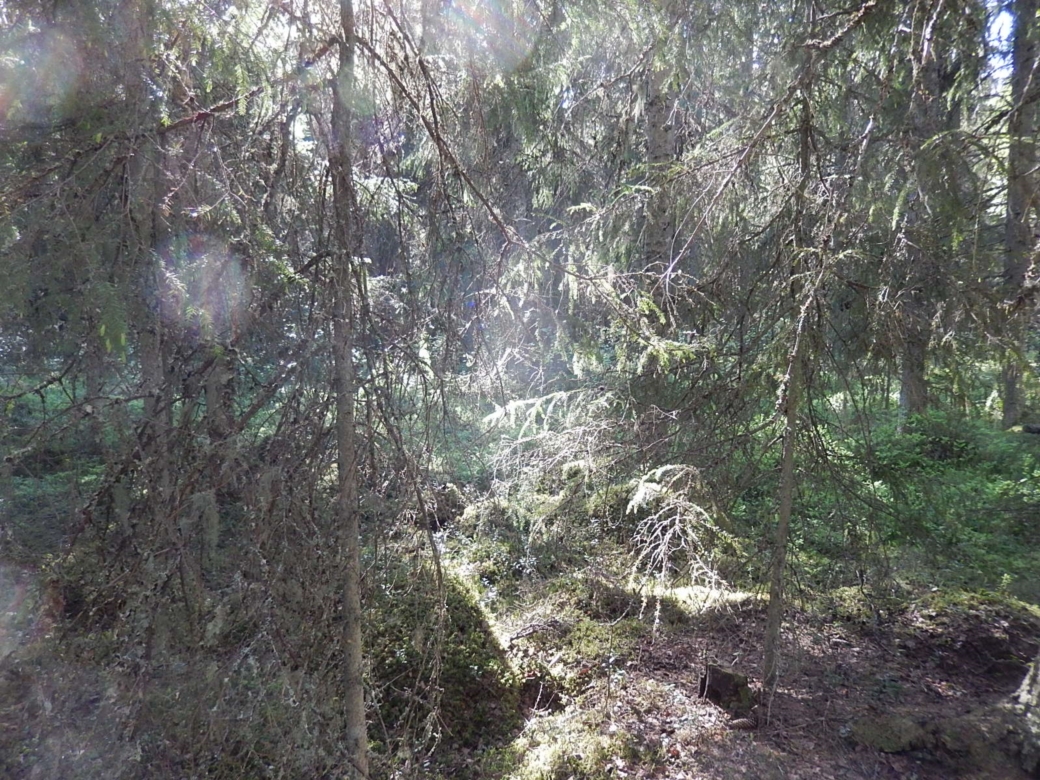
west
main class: Woodland
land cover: Spruce dominated coniferous woodland
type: boreal forest
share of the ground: > 75 %
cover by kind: coniferous forest trees 80 %, shrubs 10 %, lichens and mosses 10 %
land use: Forestry
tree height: > 5 m
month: June
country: FI
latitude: 61.9539
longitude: 21.4669
